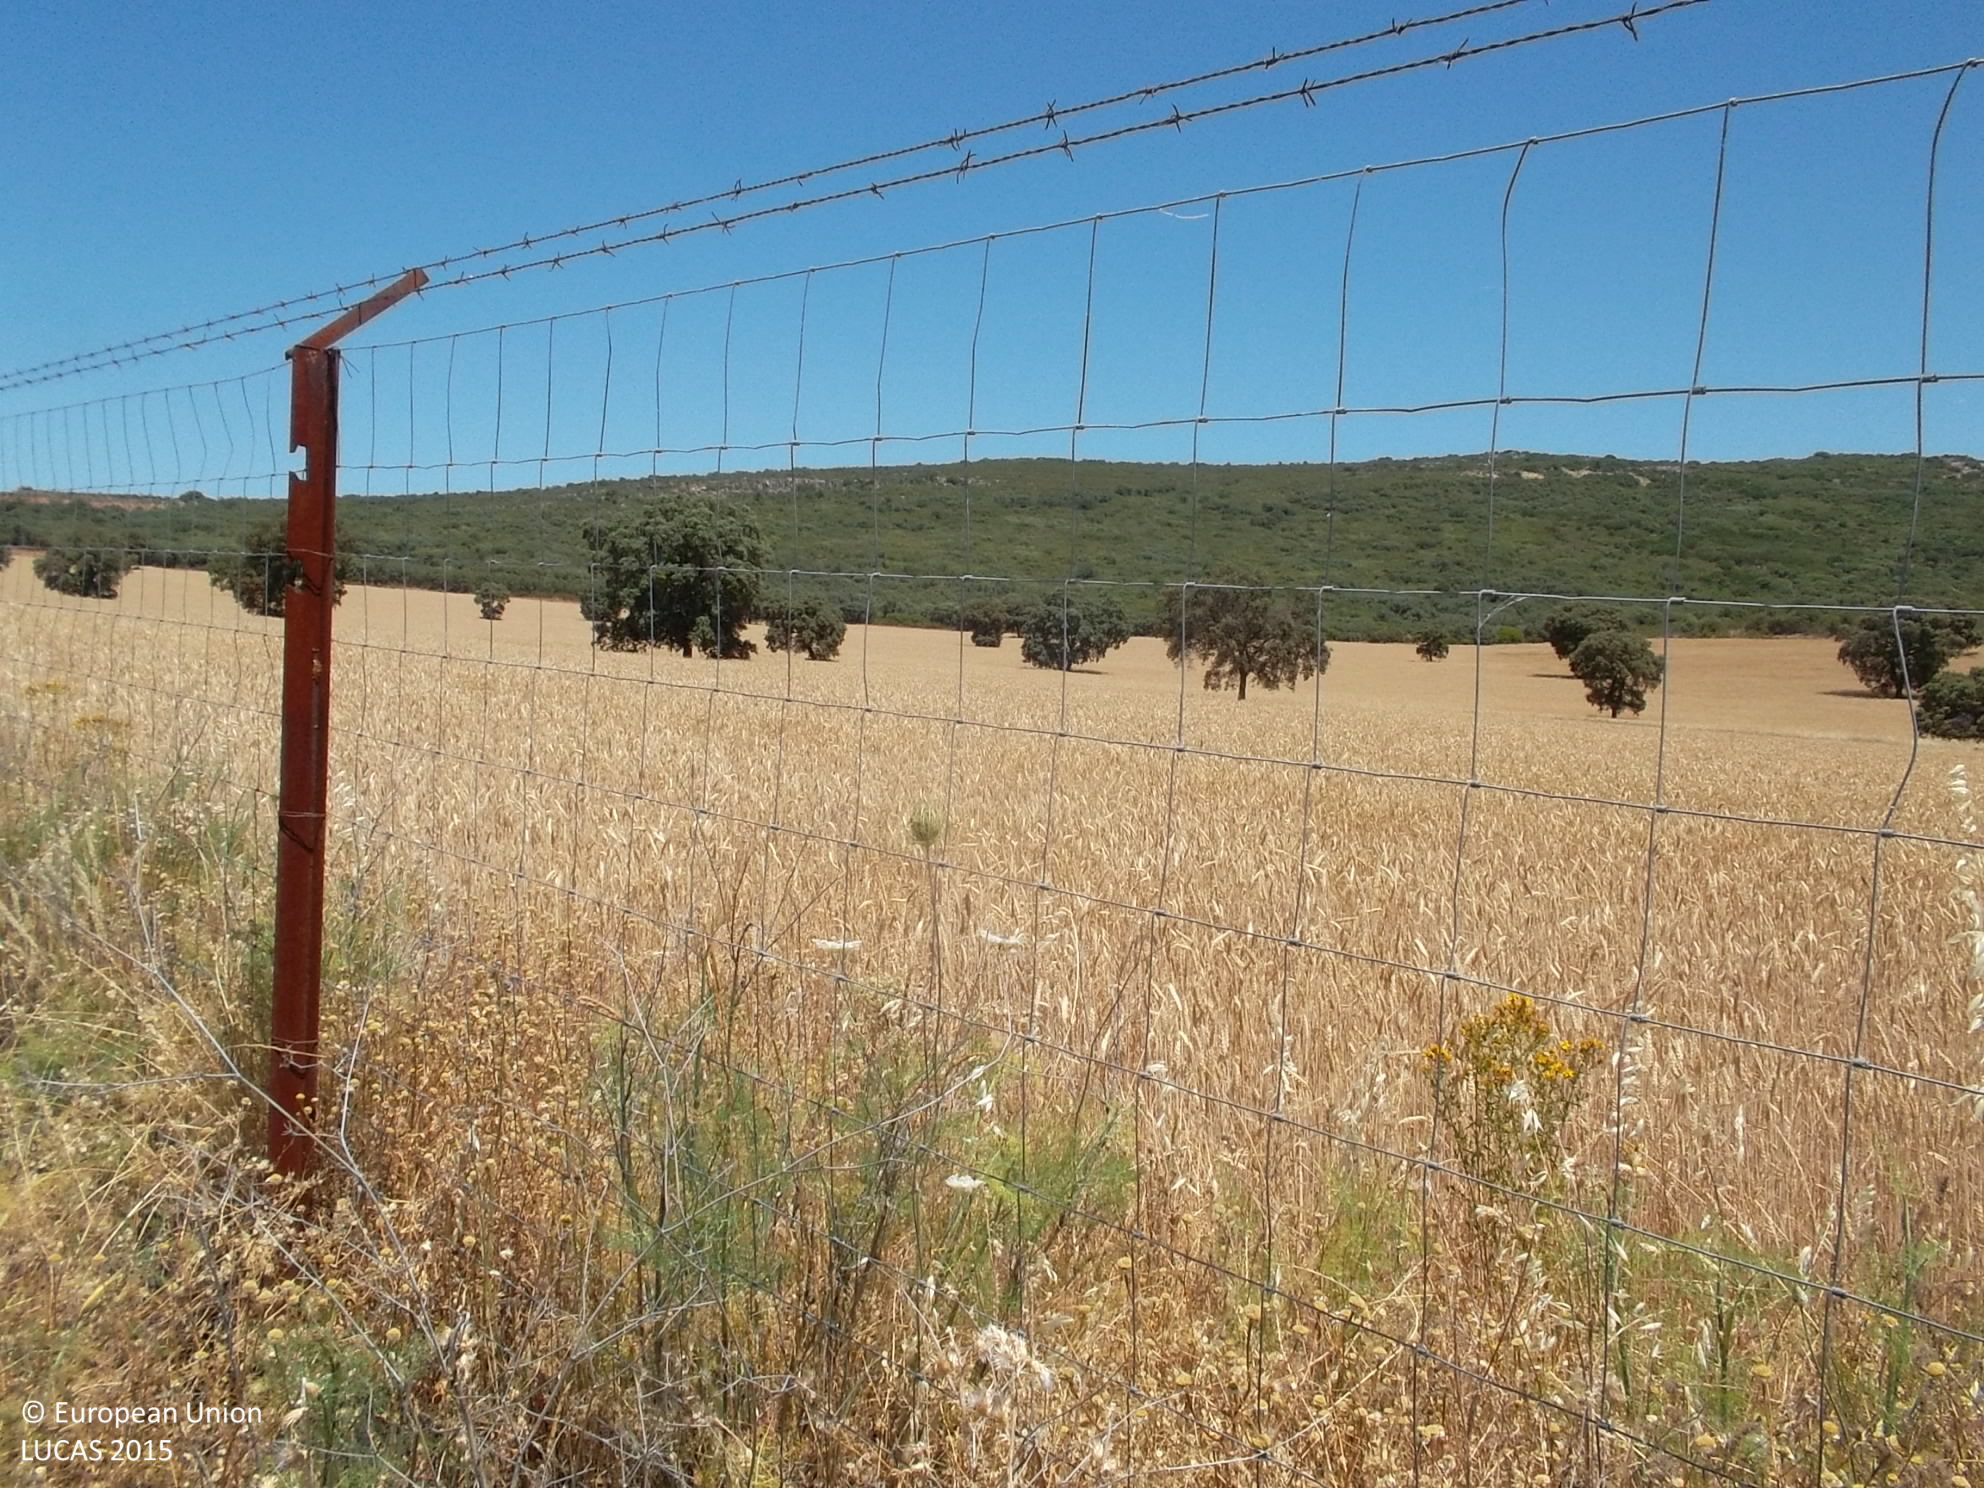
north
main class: Cropland
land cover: Common wheat
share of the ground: > 75 %
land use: Agriculture (excluding fallow land and kitchen gardens)
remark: Harvested field
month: June
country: ES
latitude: 39.0973
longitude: -4.0959
